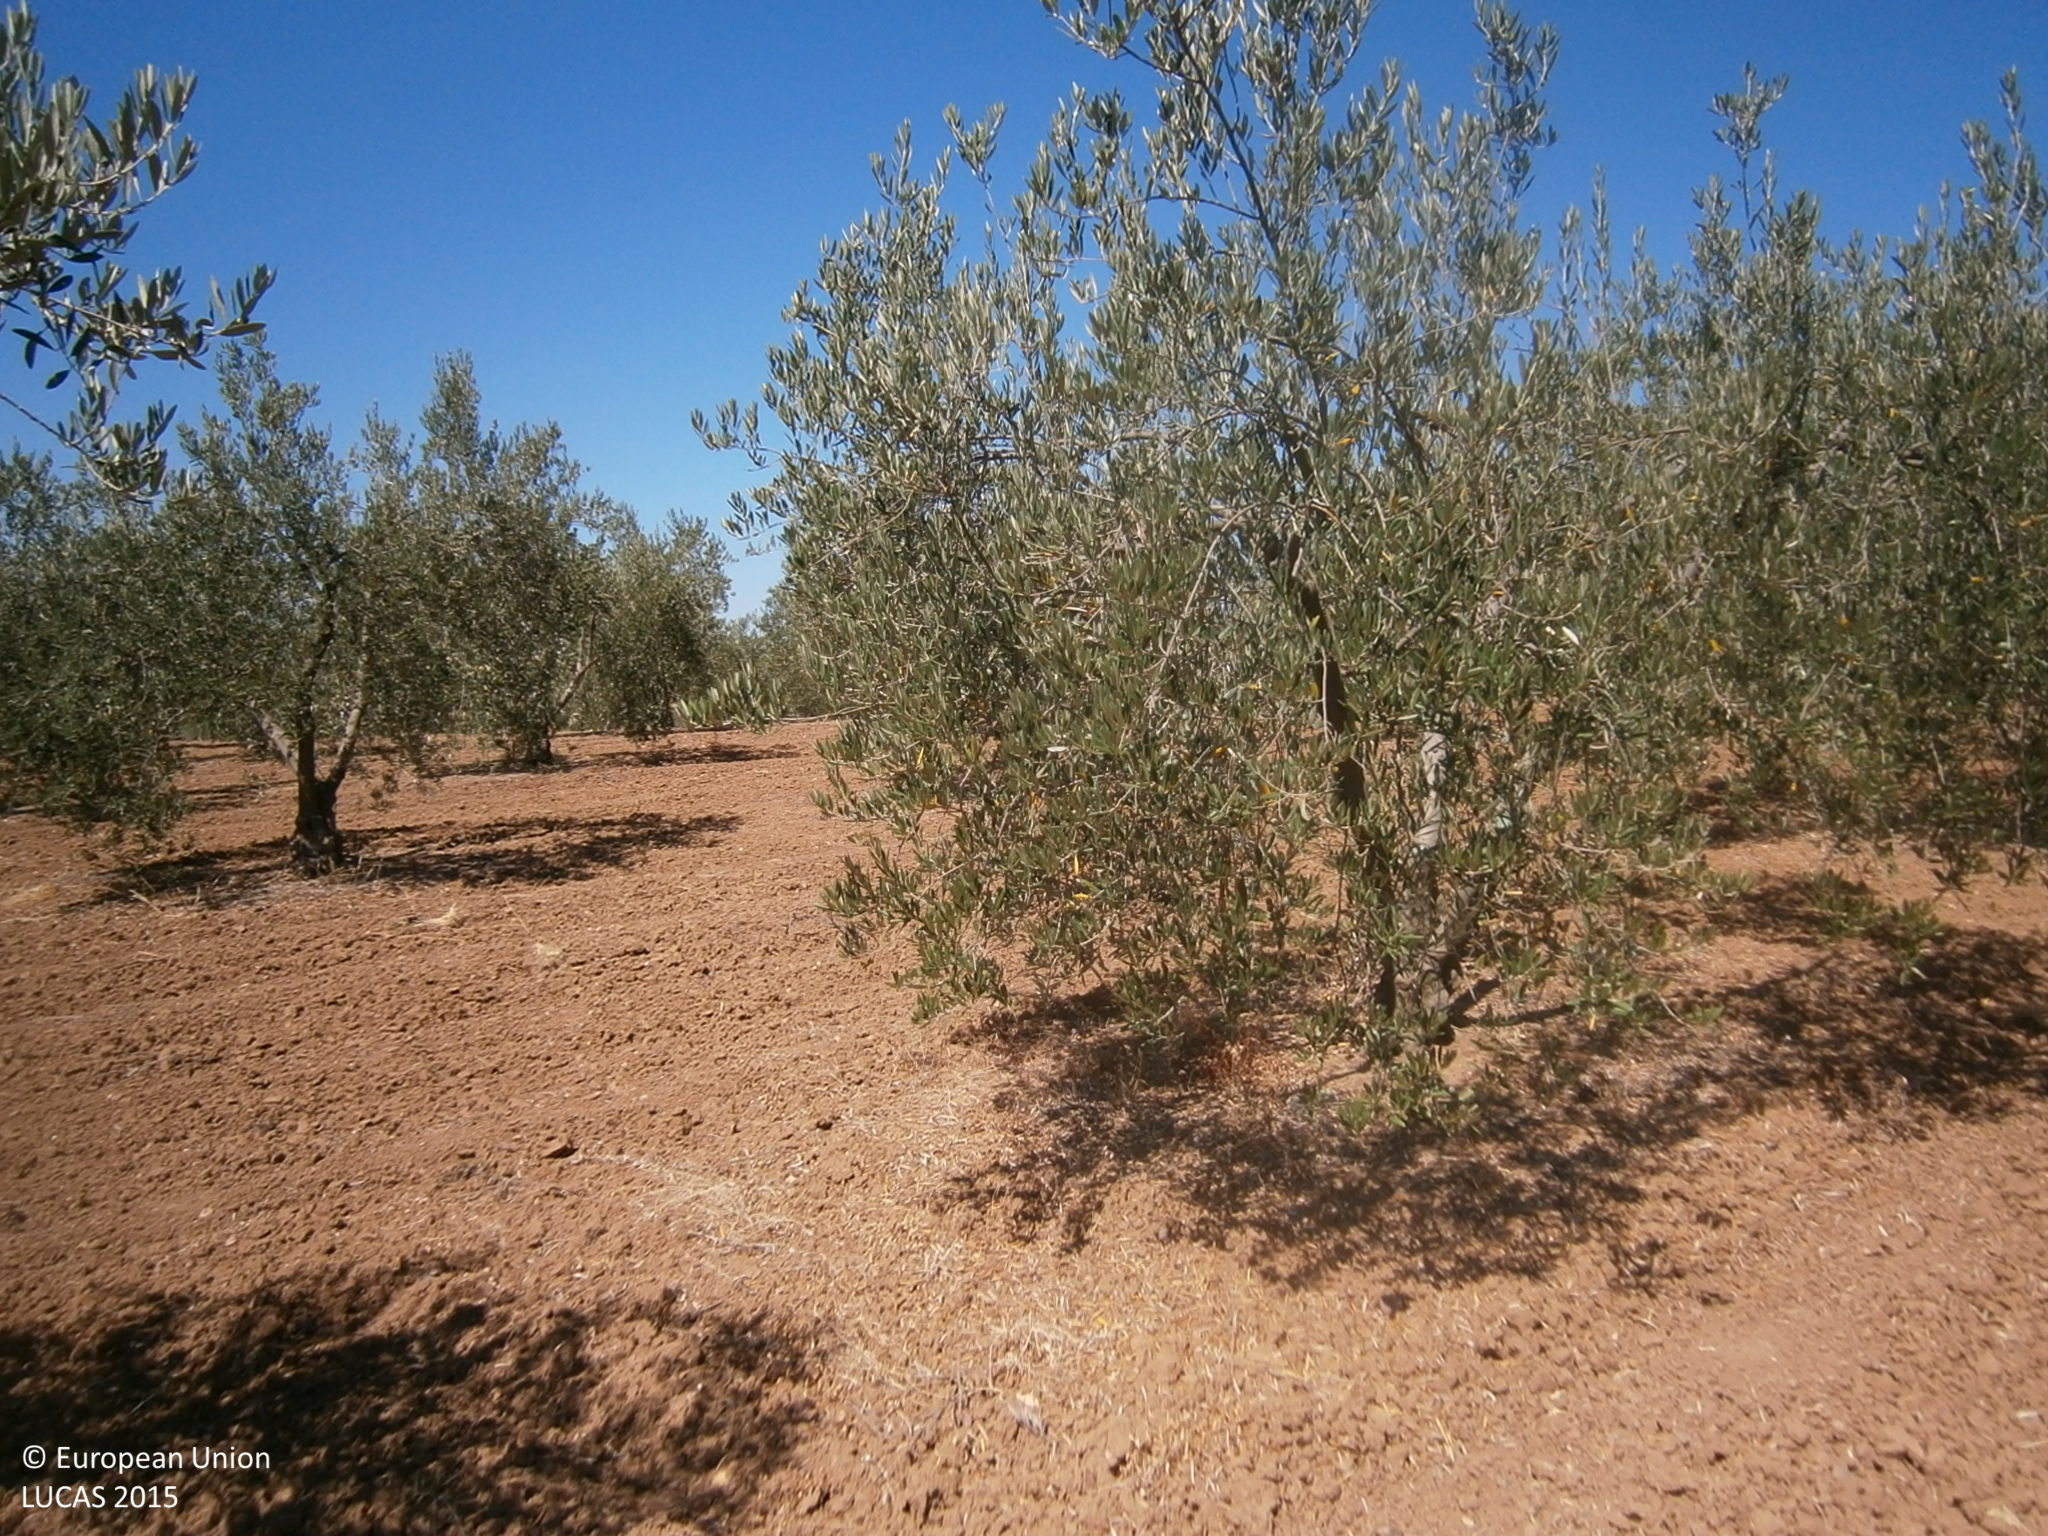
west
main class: Cropland
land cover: Olive groves
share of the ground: 25 - 50 %
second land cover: Other bare soil
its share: > 75 %
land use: Agriculture (excluding fallow land and kitchen gardens)
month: July
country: ES
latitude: 38.9165
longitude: -7.0137
